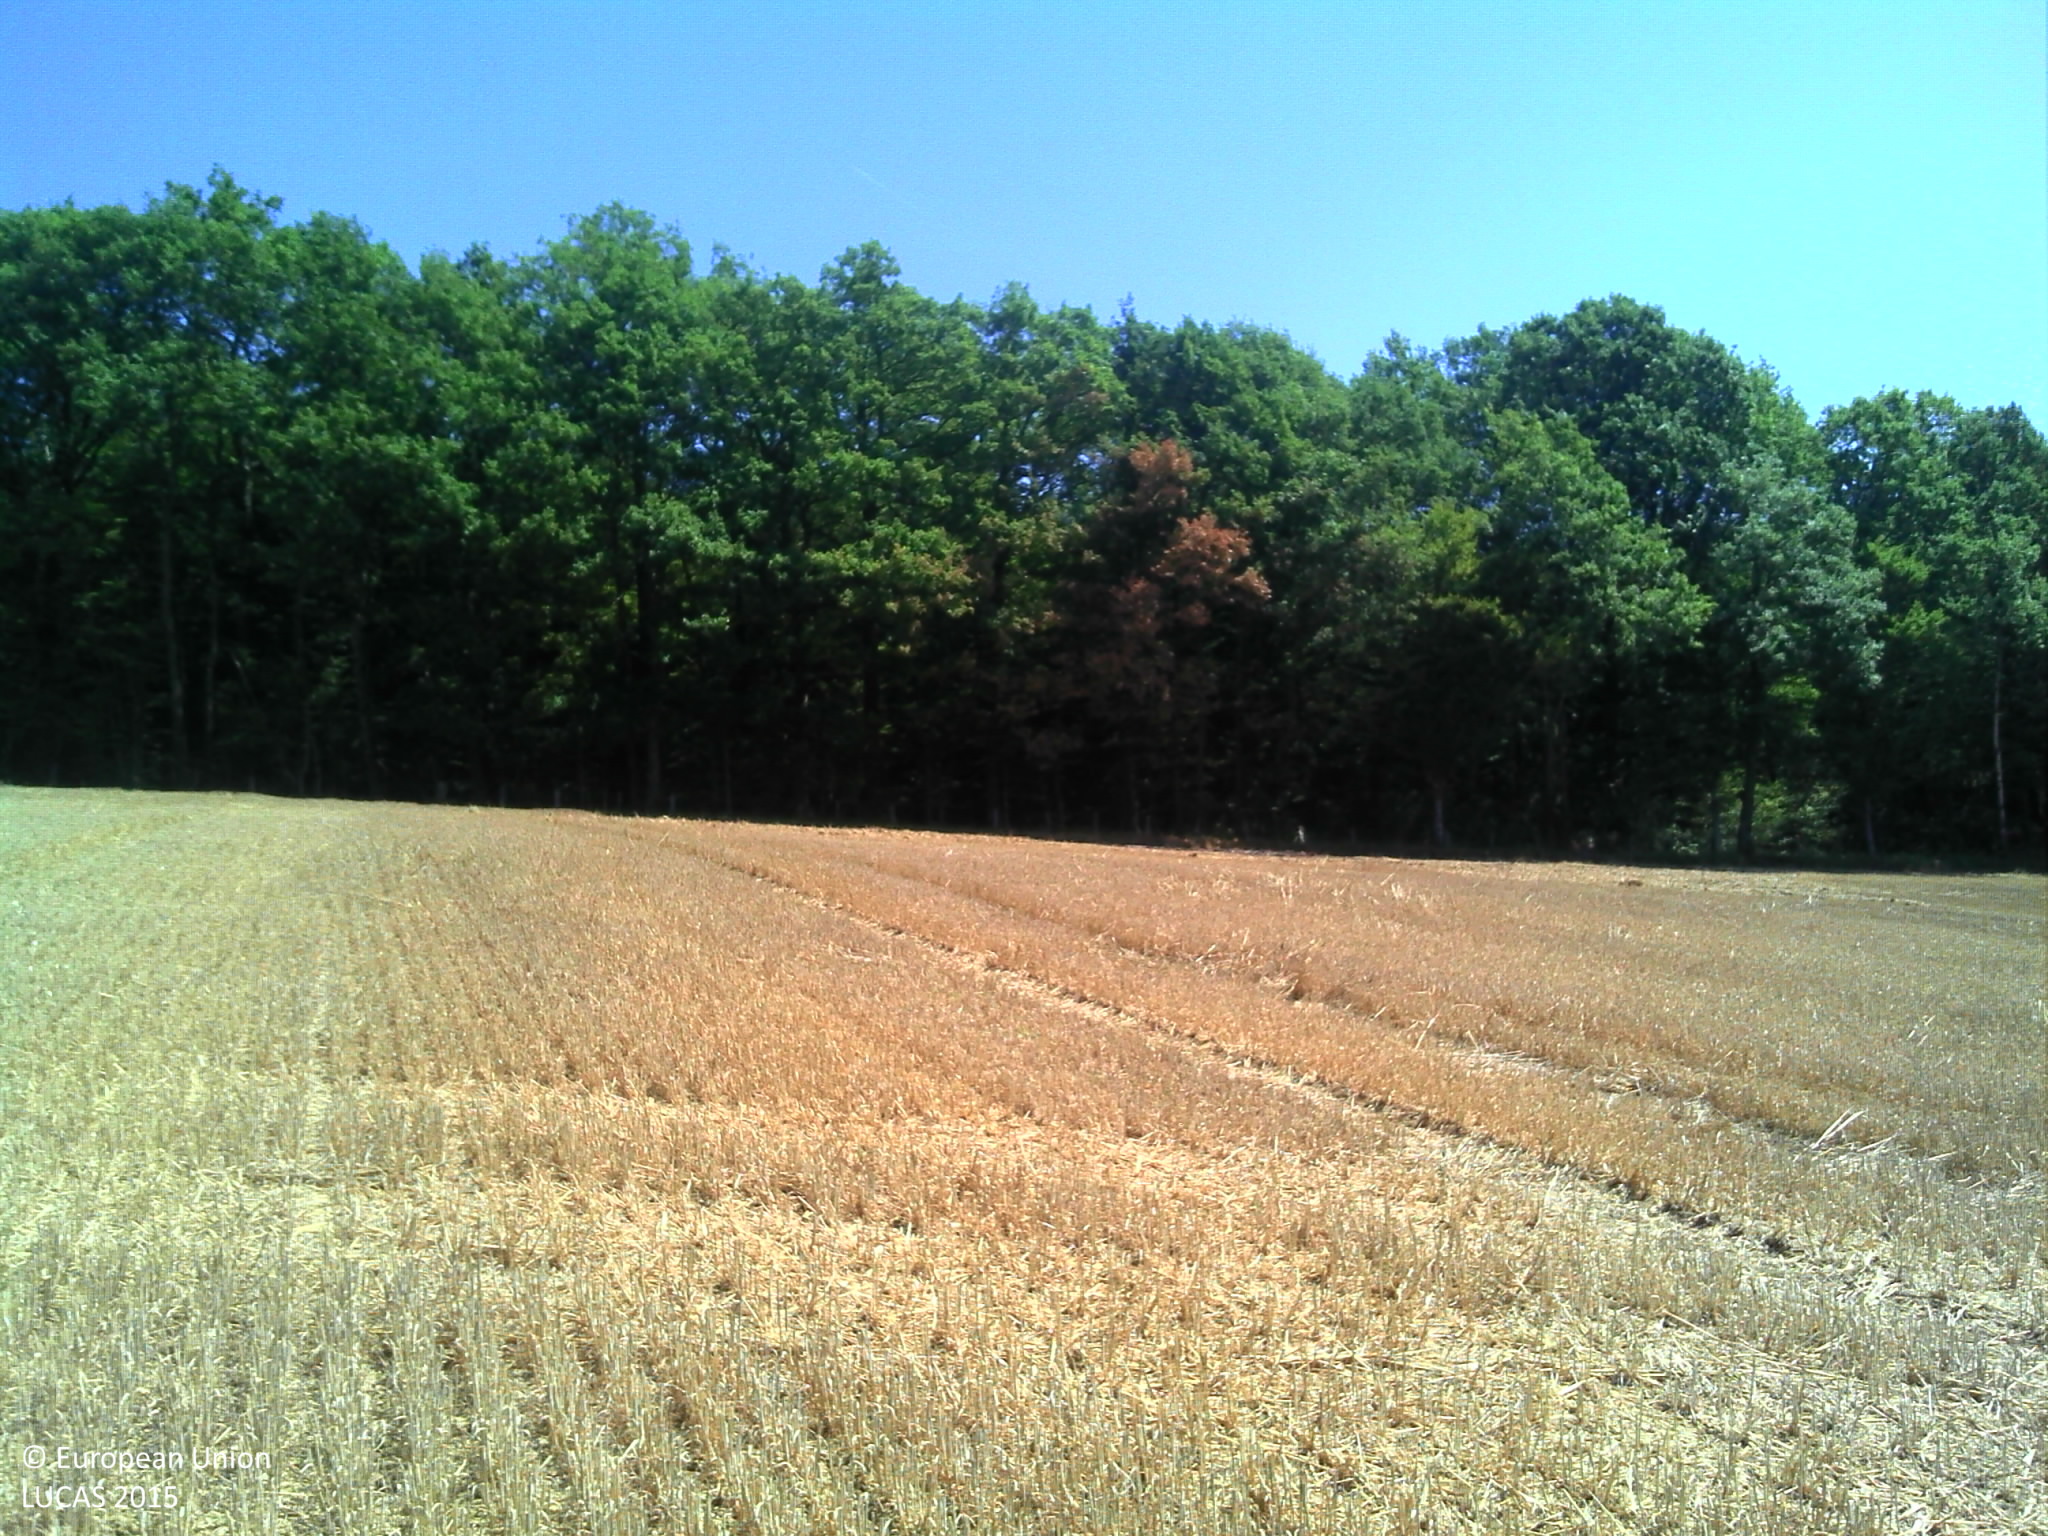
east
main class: Cropland
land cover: Common wheat
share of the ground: 10 - 25 %
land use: Agriculture (excluding fallow land and kitchen gardens)
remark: Harvested field
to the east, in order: Common wheat; Grass margins; Fences; Broadleaved woodland; Fences; Spruce dominated coniferous woodland; Fences; Broadleaved woodland
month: August
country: FR
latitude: 47.6709
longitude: 6.1788
